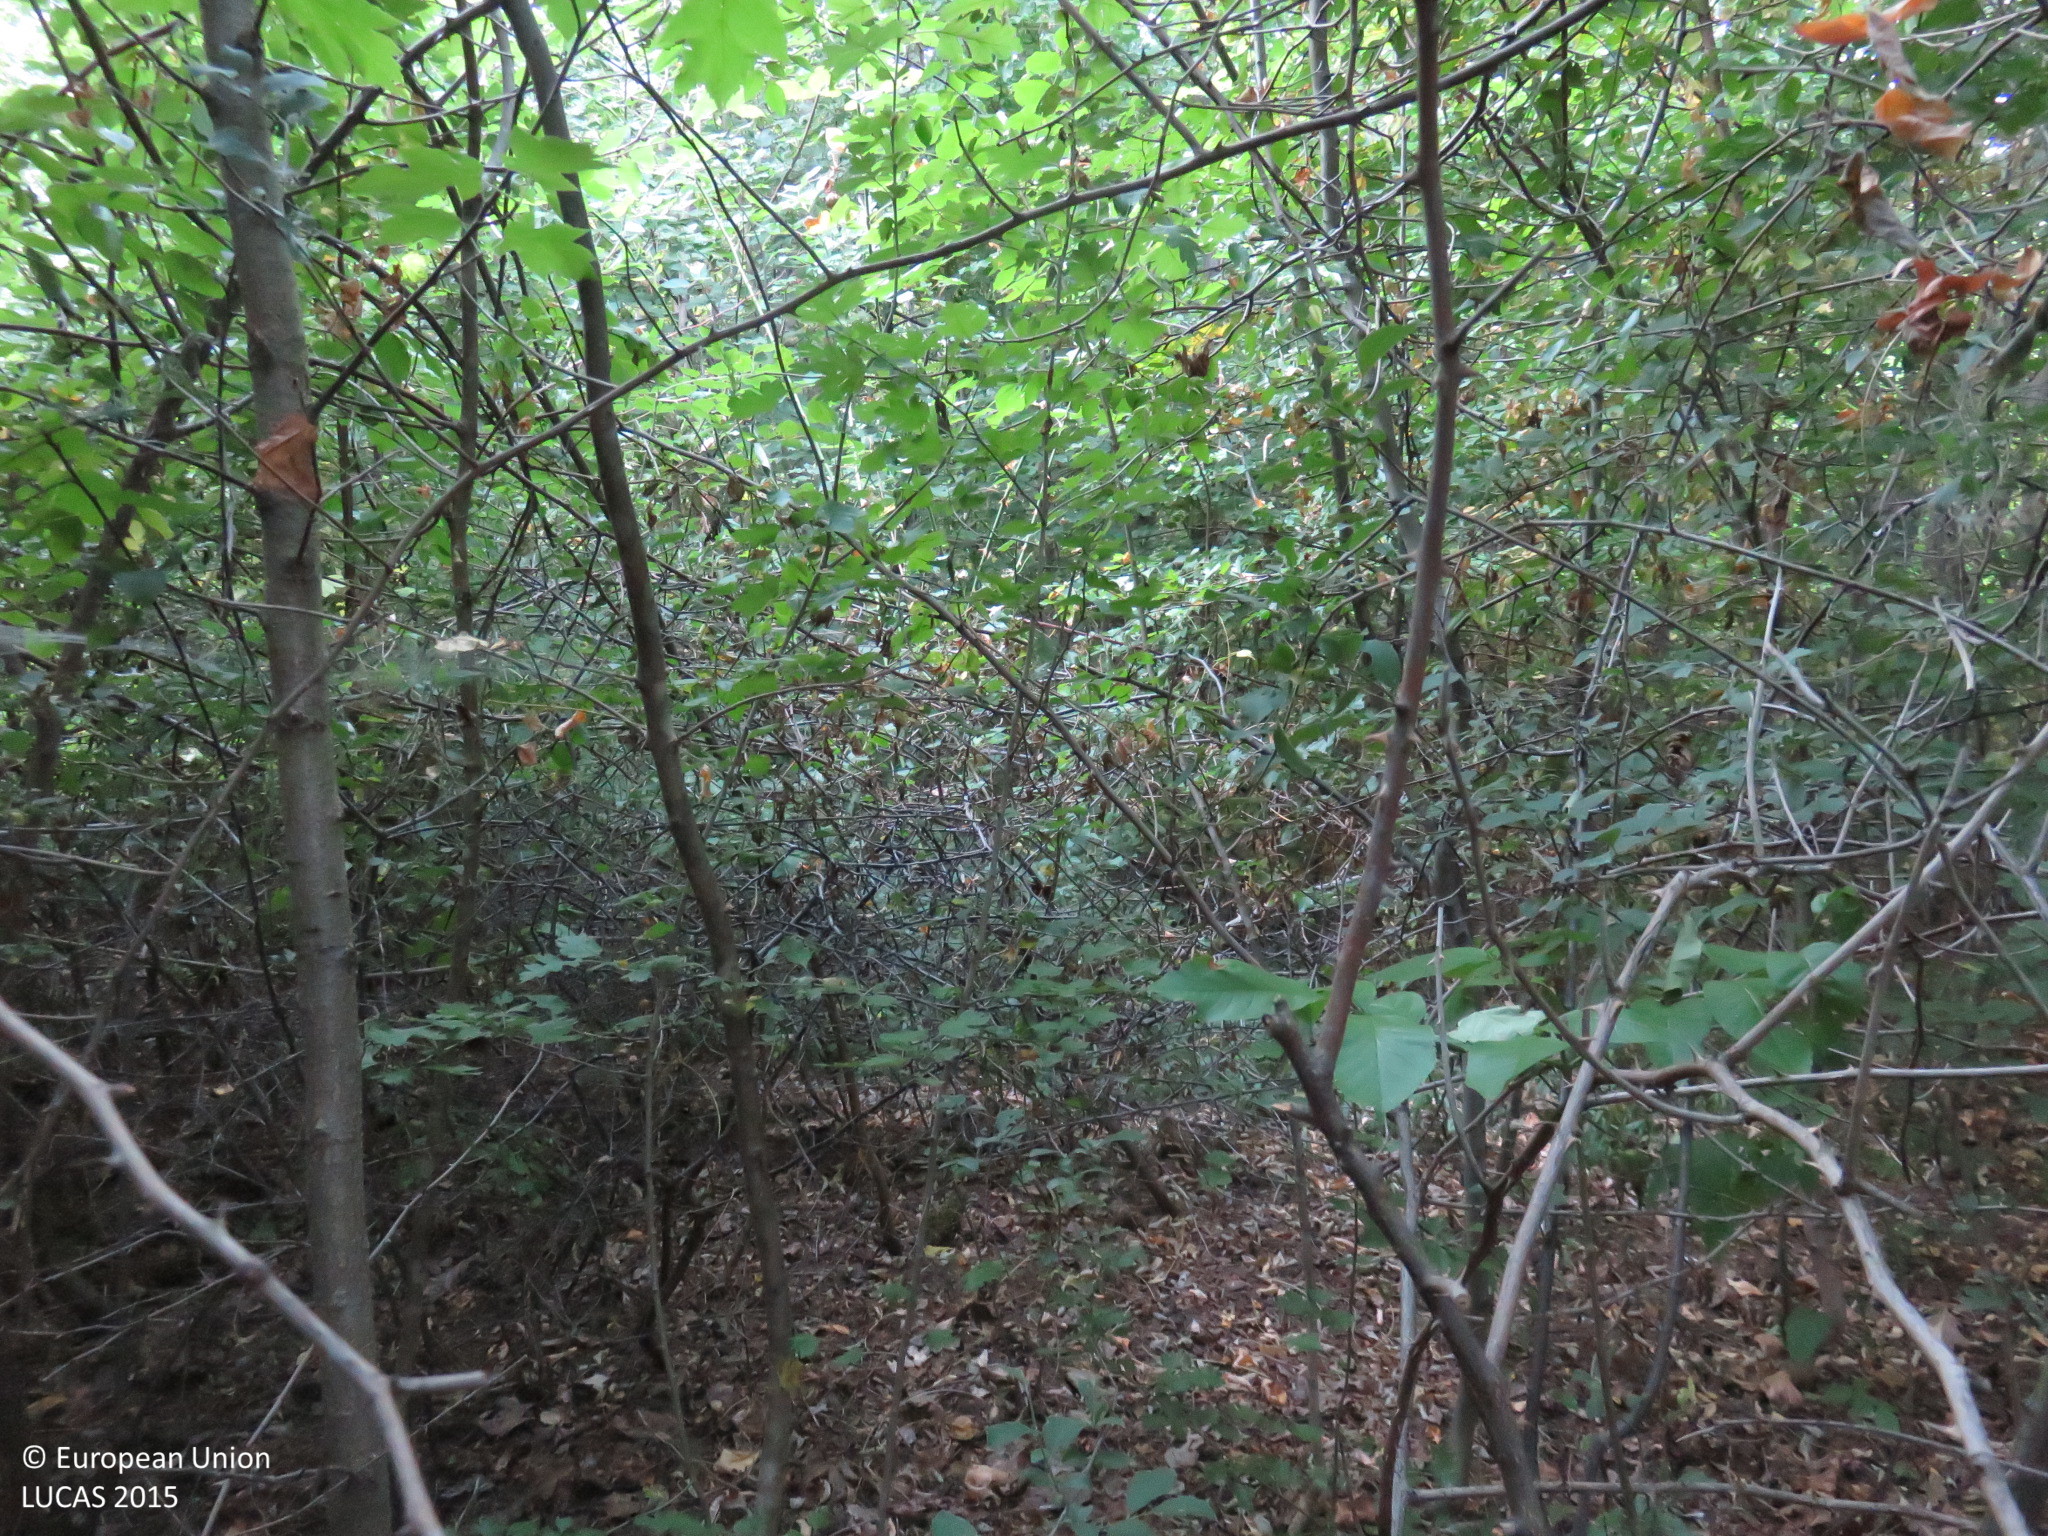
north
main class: Woodland
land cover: Broadleaved woodland
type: mesophytic deciduous forest
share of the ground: > 75 %
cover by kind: broadleaved forest trees 75 %, shrubs 25 %
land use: Forestry
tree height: < 5 m
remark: Clear cut
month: July
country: BG
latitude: 43.2438
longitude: 25.1833
